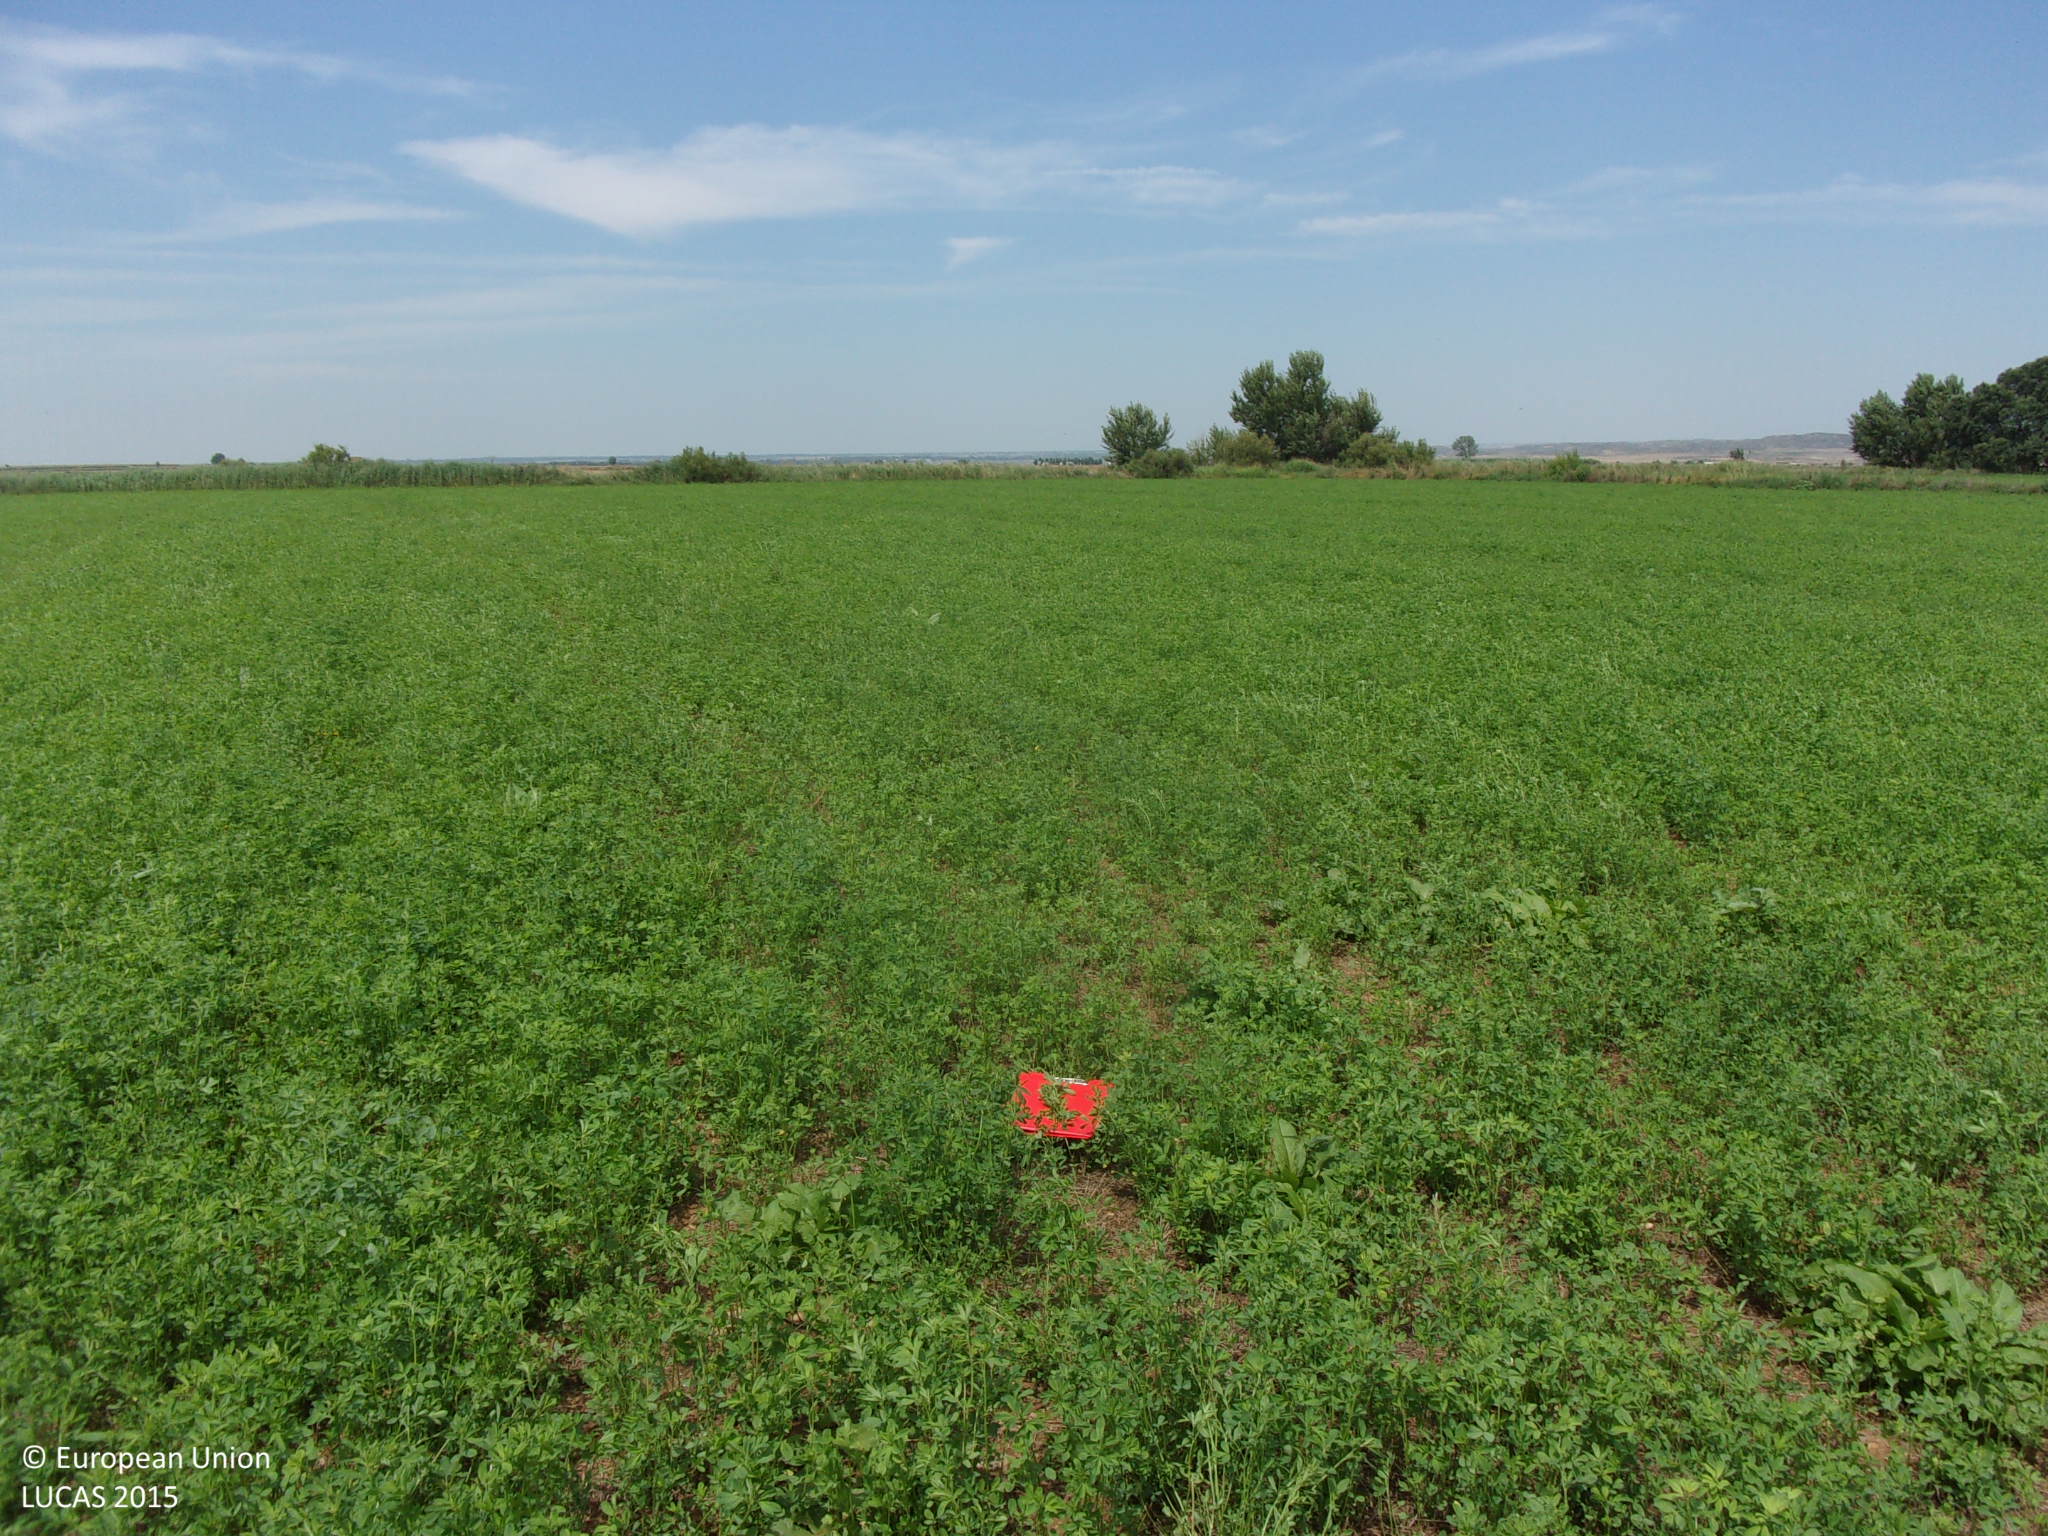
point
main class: Cropland
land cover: Lucerne
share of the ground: > 75 %
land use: Agriculture (excluding fallow land and kitchen gardens)
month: August
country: ES
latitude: 42.1208
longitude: -1.0465
